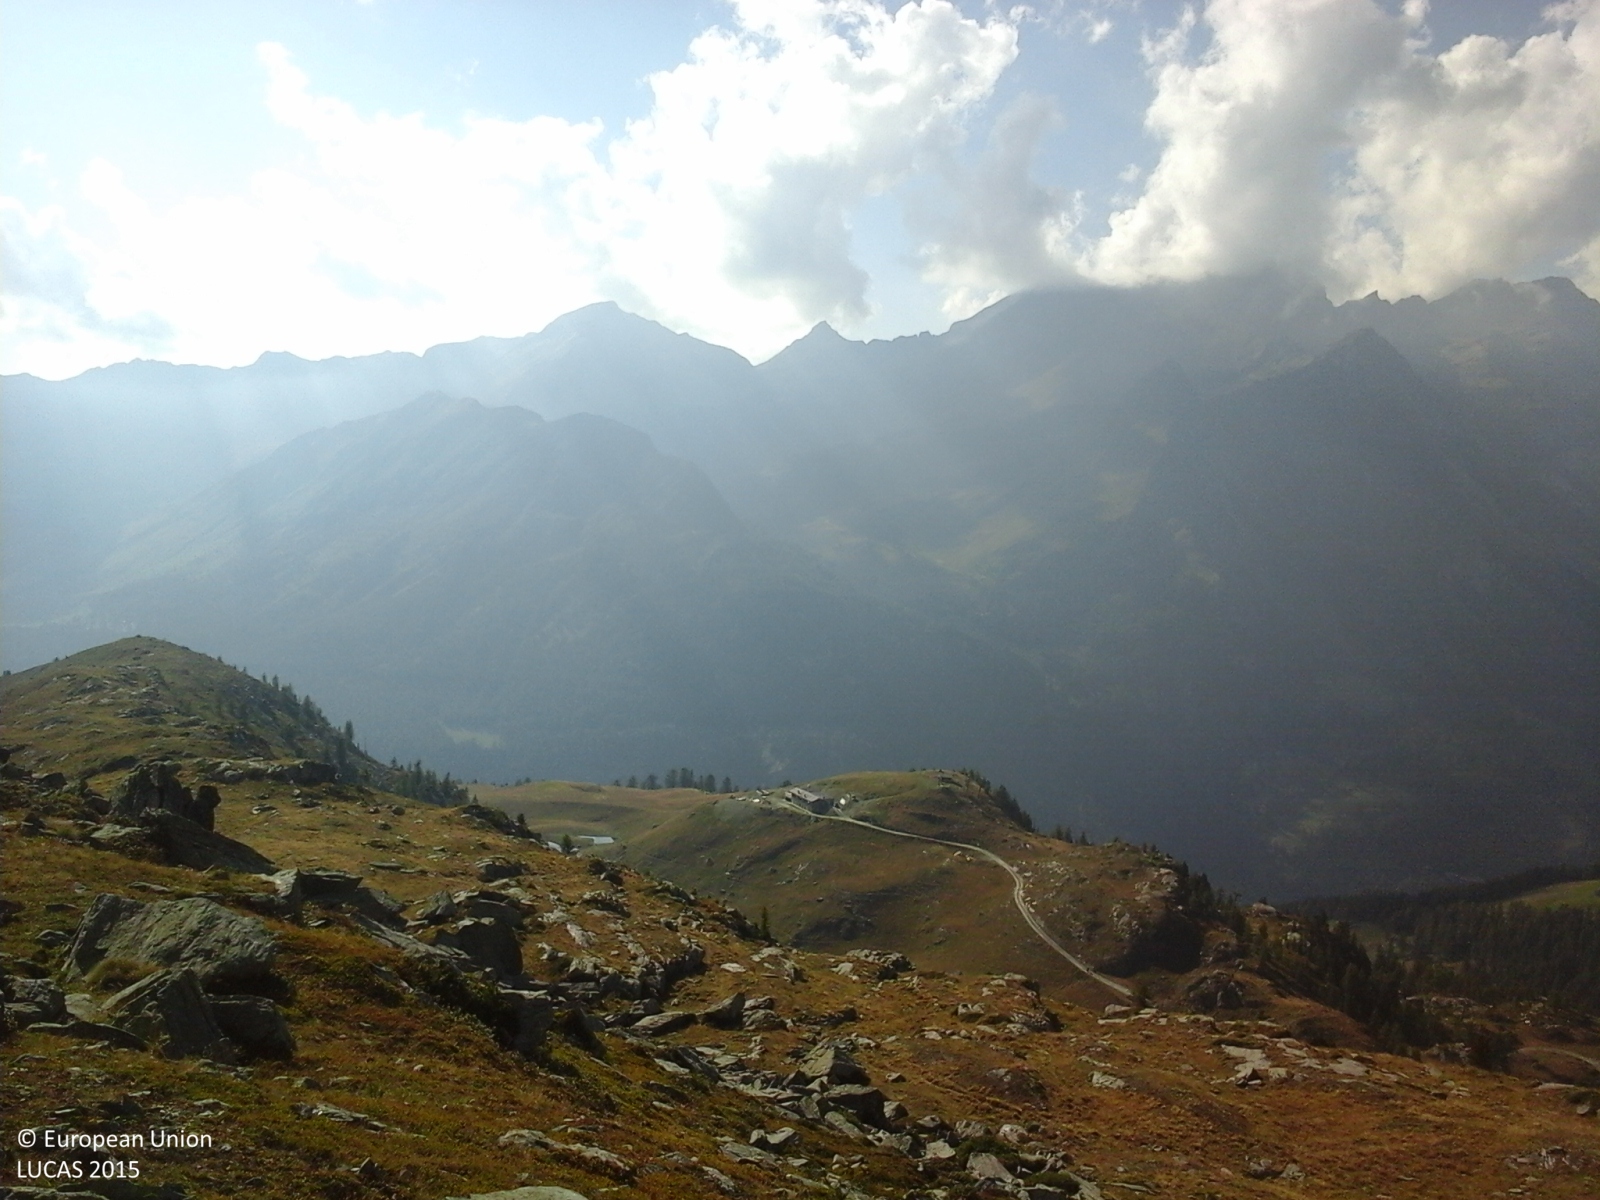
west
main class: Grassland
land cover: Grassland without tree/shrub cover
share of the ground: > 75 %
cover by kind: herbaceous plants 100 %
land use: Agriculture (excluding fallow land and kitchen gardens)
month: August
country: IT
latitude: 45.8410
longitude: 7.7499
